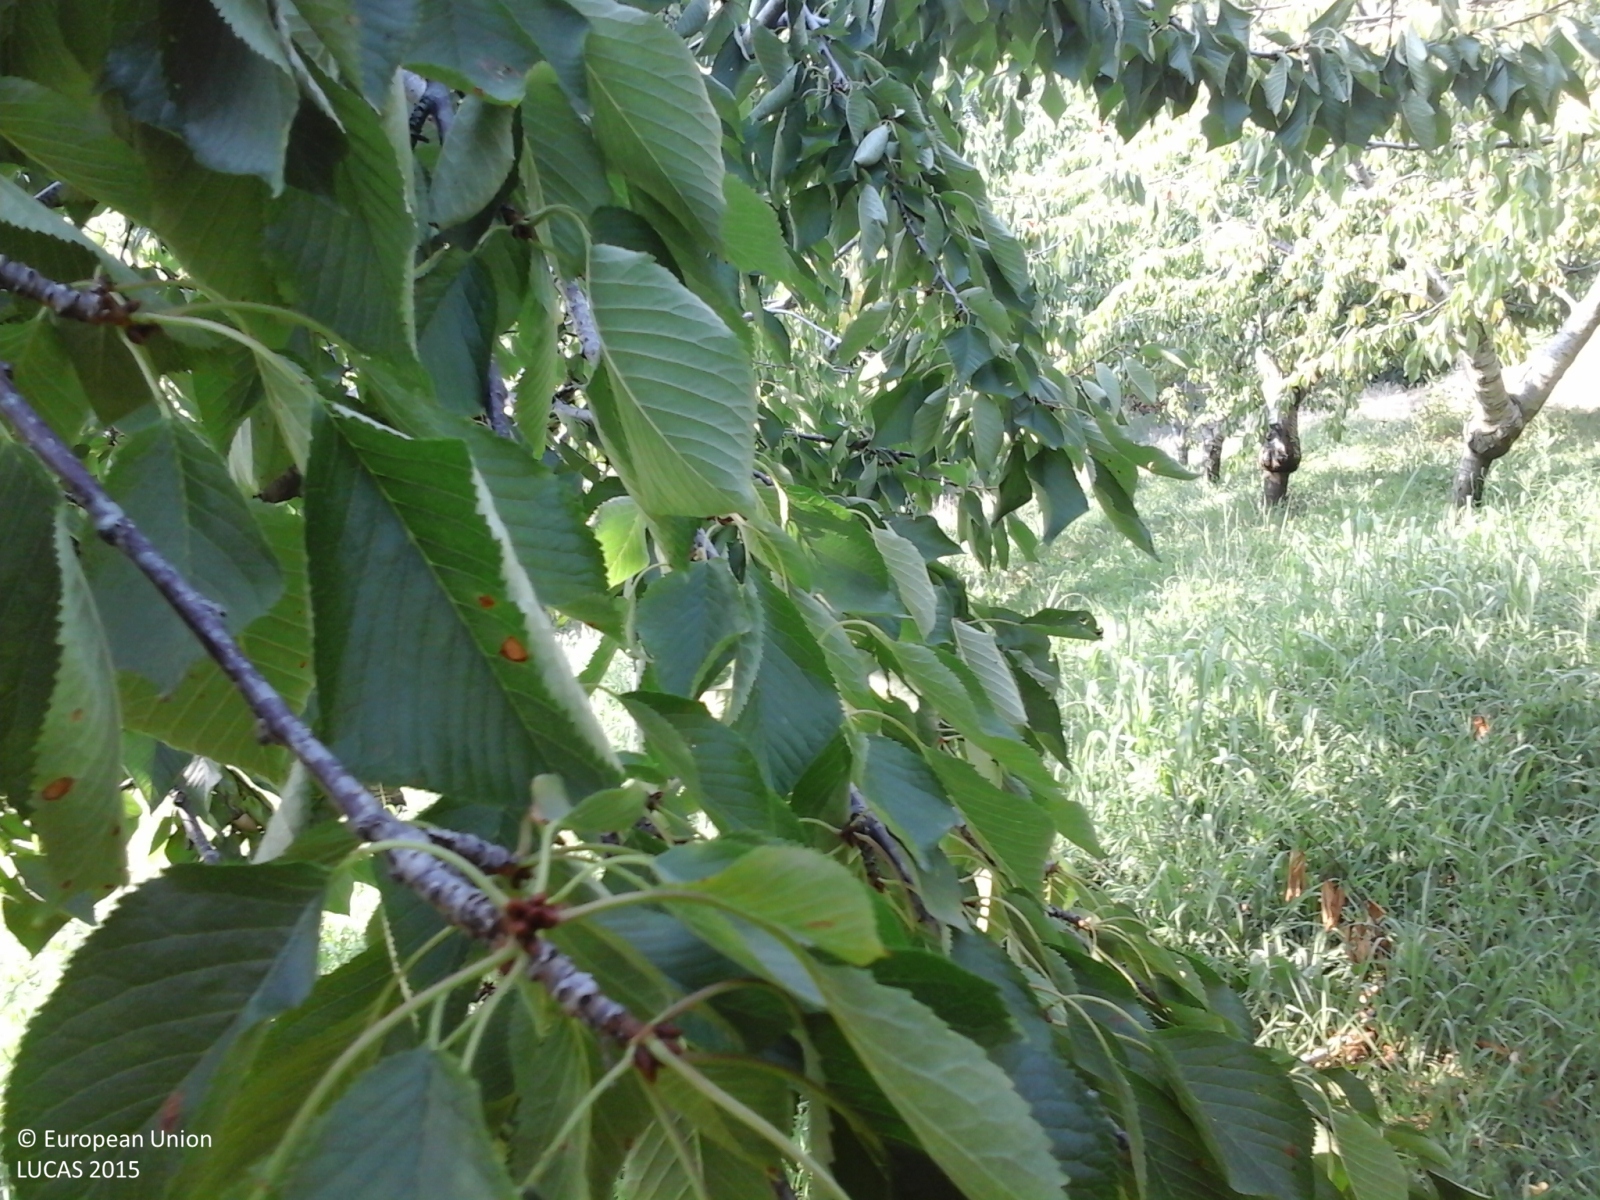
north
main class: Cropland
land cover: Cherry fruit
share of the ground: > 75 %
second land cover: Grassland without tree/shrub cover
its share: > 75 %
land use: Agriculture (excluding fallow land and kitchen gardens)
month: July
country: IT
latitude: 45.5512
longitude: 11.2404
